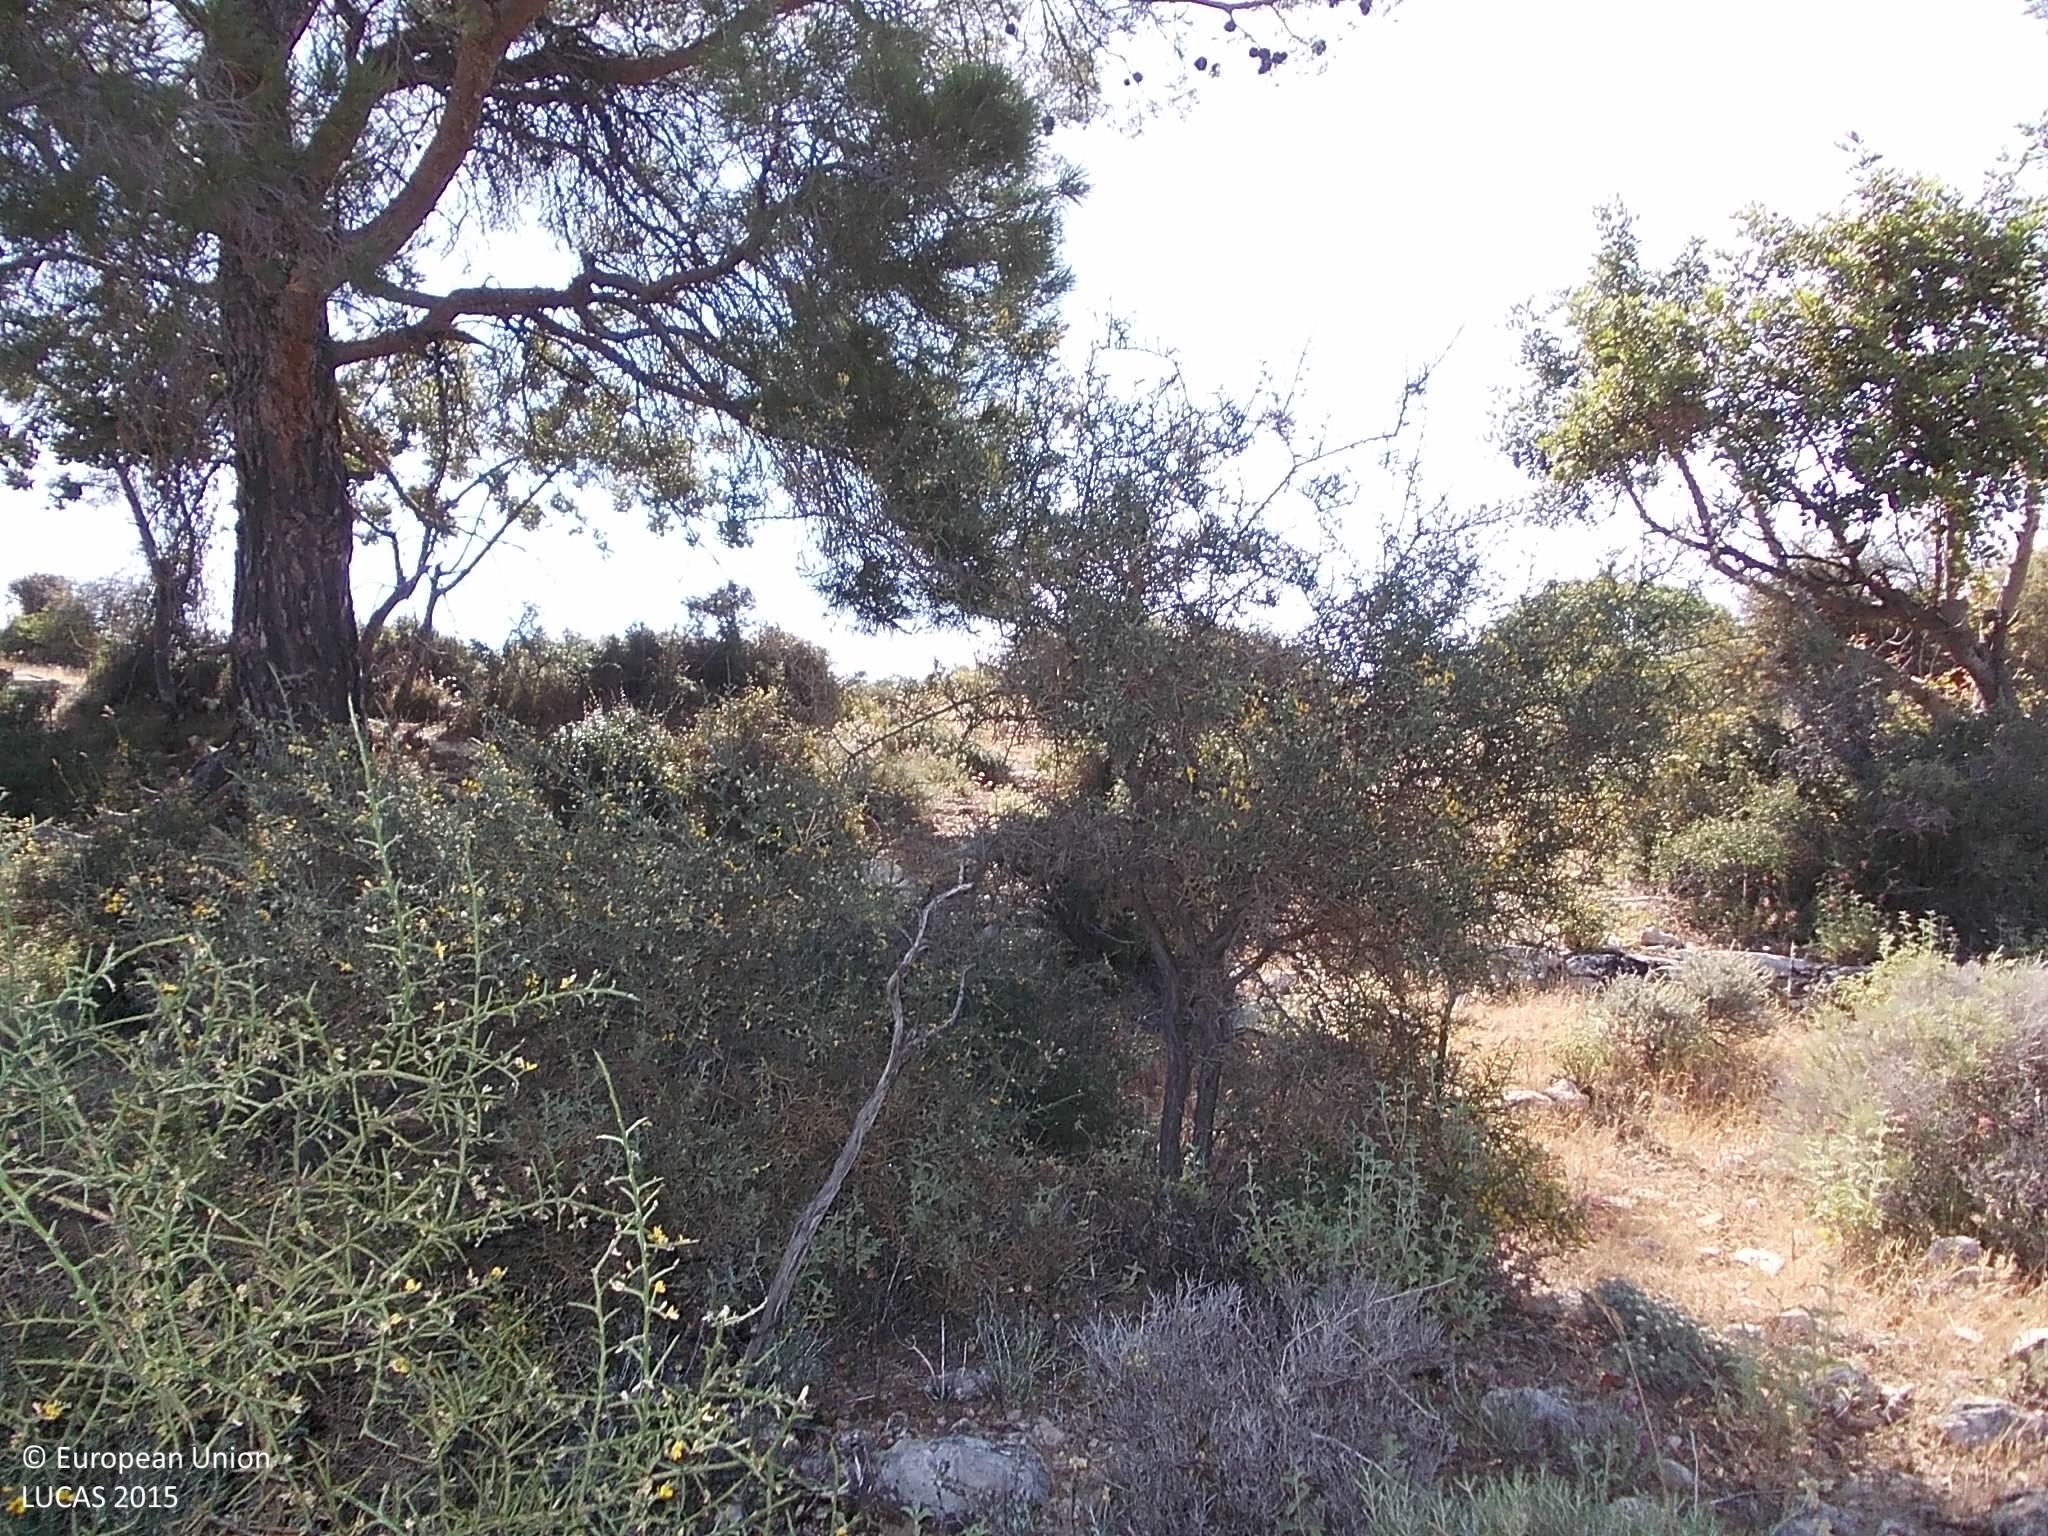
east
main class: Shrubland
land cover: Shrubland with sparse tree cover
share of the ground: > 75 %
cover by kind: shrubs 70 %, herbaceous plants 15 %, unconsolidated bare surface 10 %, coniferous forest trees 5 %
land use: Semi-natural and natural areas not in use
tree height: > 5 m
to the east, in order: Shrubland with sparse tree cover; Shrubland without tree cover; Paved roads, cycling and walking lanes; Pine dominated mixed woodland; Shrubland without tree cover; Grassland without tree/shrub cover; Shrubland without tree cover; Rivers and streams; Shrubland without tree cover; Tracks; Pine dominated coniferous woodland; Broadleaved woodland; Spontaneously vegetated surfaces
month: June
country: CY
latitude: 34.7184
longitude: 32.9288
